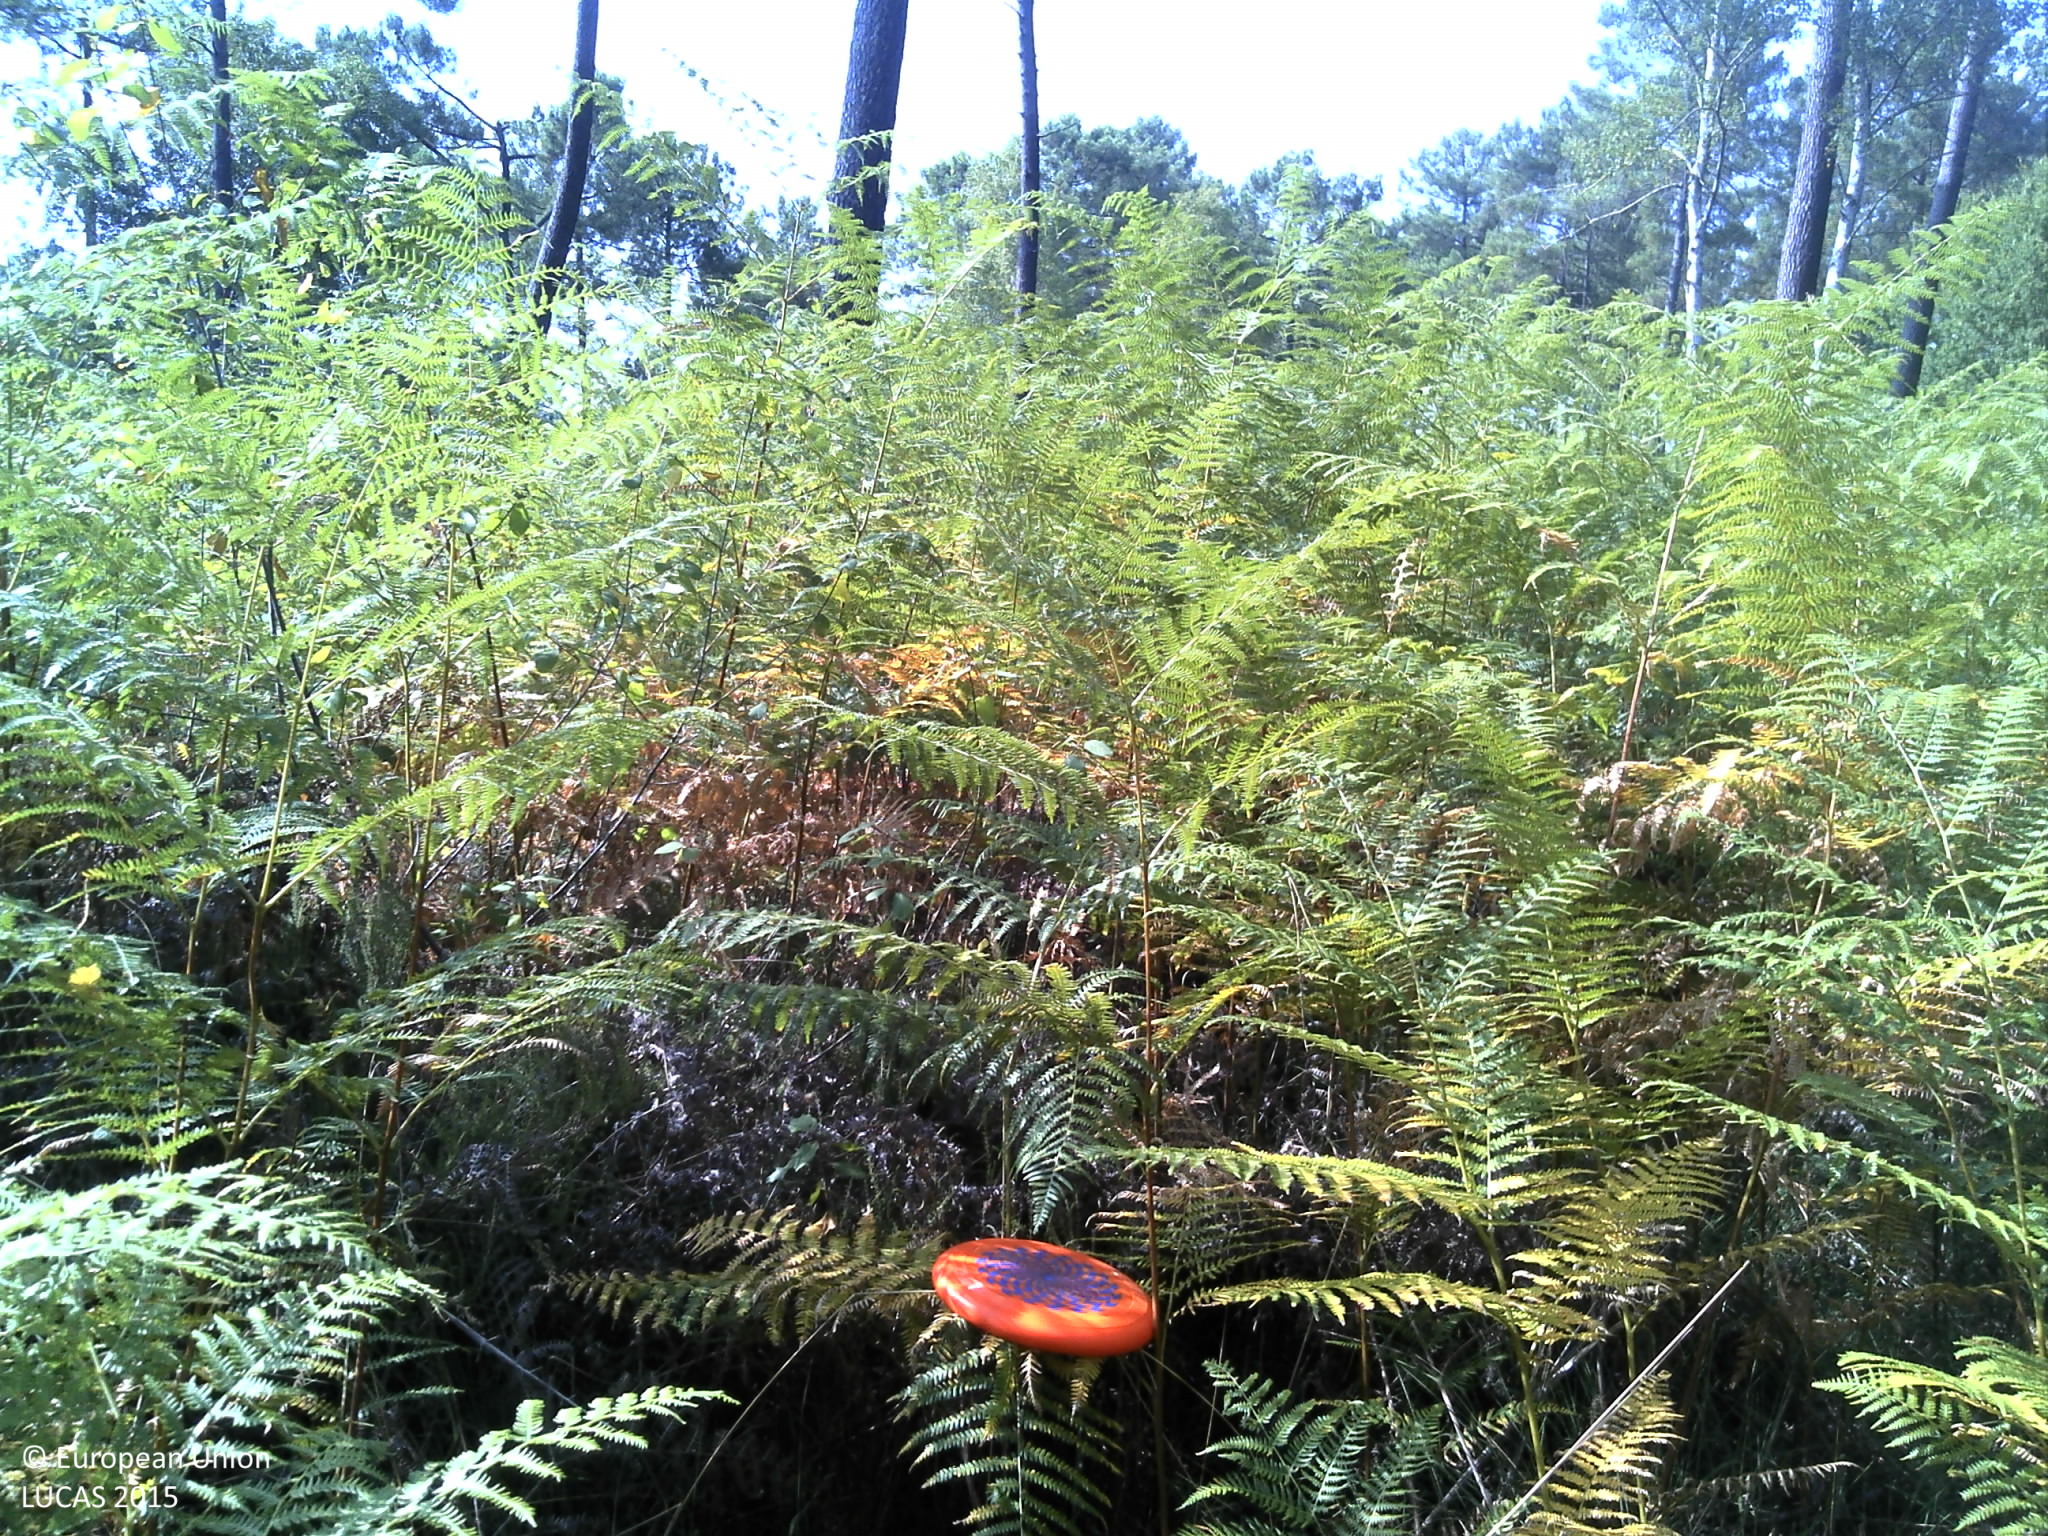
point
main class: Woodland
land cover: Pine dominated coniferous woodland
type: exotic forest
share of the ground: > 75 %
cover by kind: coniferous forest trees 70 %, shrubs 25 %, herbaceous plants 5 %
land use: Forestry
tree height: > 5 m
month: July
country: FR
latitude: 44.7267
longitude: -0.6624
